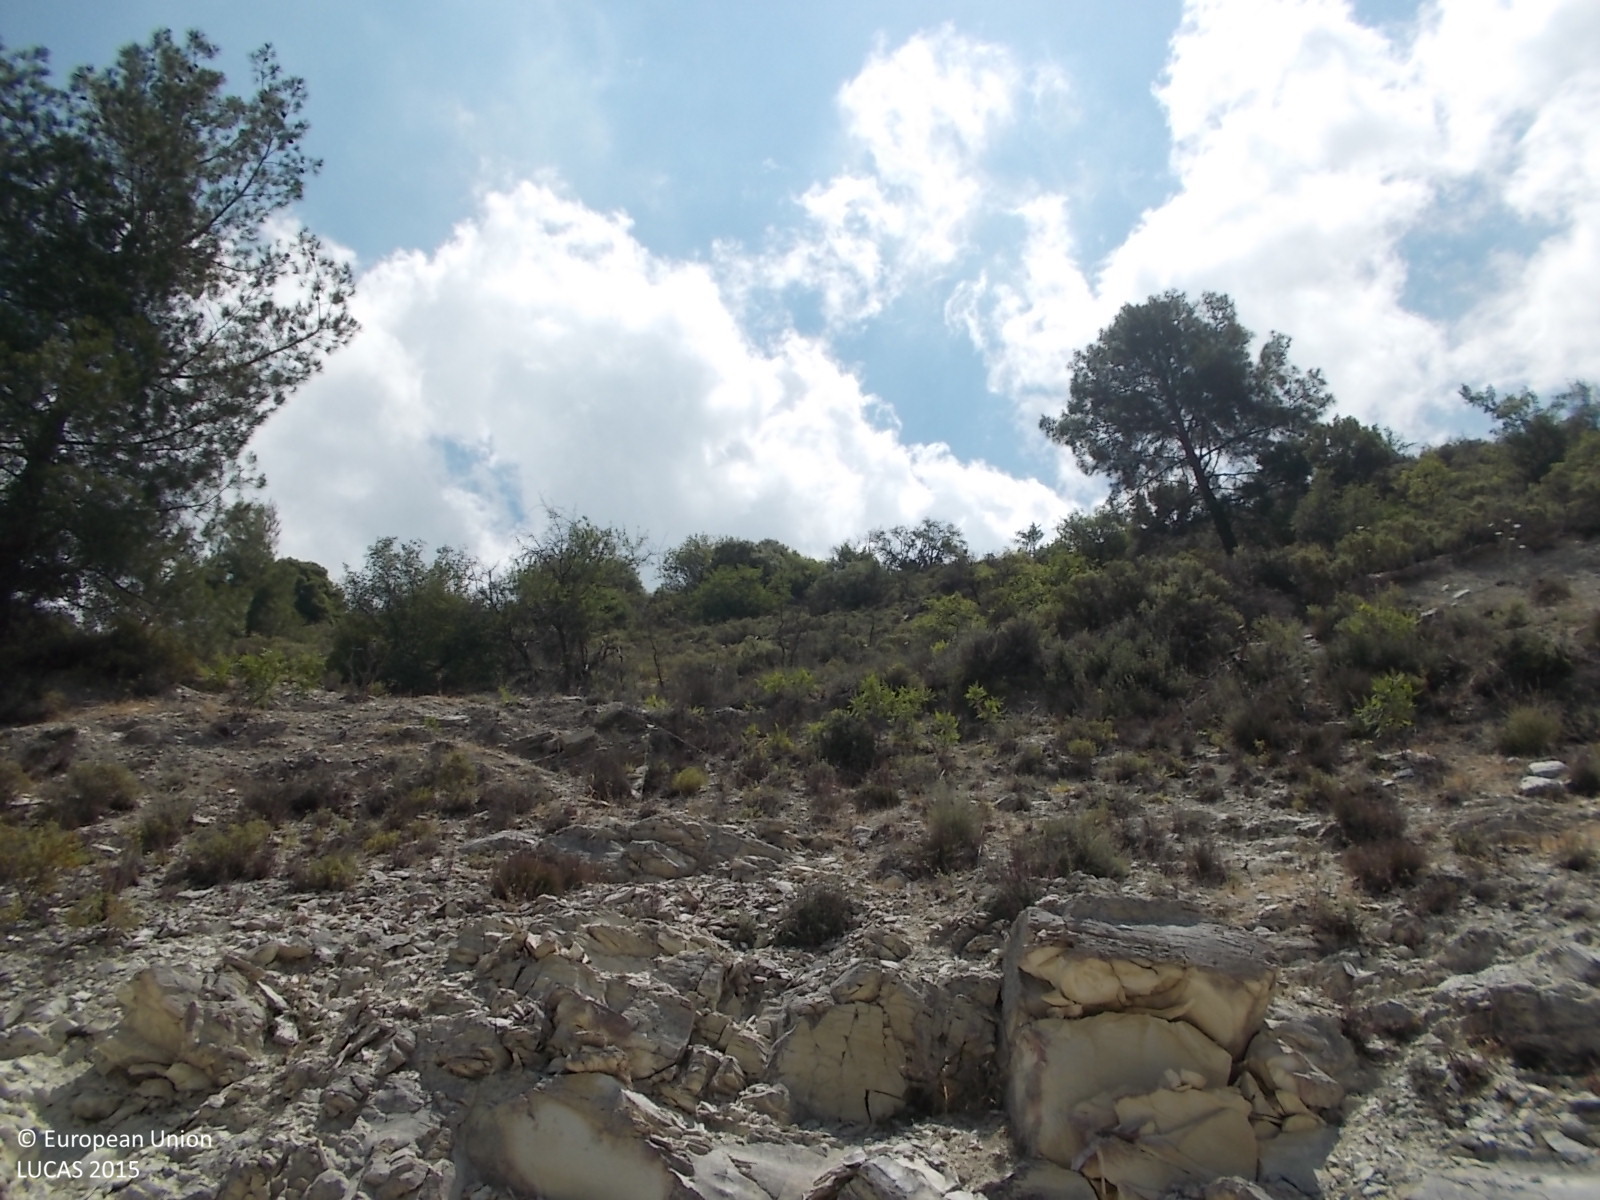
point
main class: Shrubland
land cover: Shrubland with sparse tree cover
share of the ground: > 75 %
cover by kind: shrubs 70 %, unconsolidated bare surface 15 %, consolidated bare surface 10 %, coniferous forest trees 5 %
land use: Semi-natural and natural areas not in use
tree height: > 5 m
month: June
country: CY
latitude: 34.8705
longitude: 32.7729
